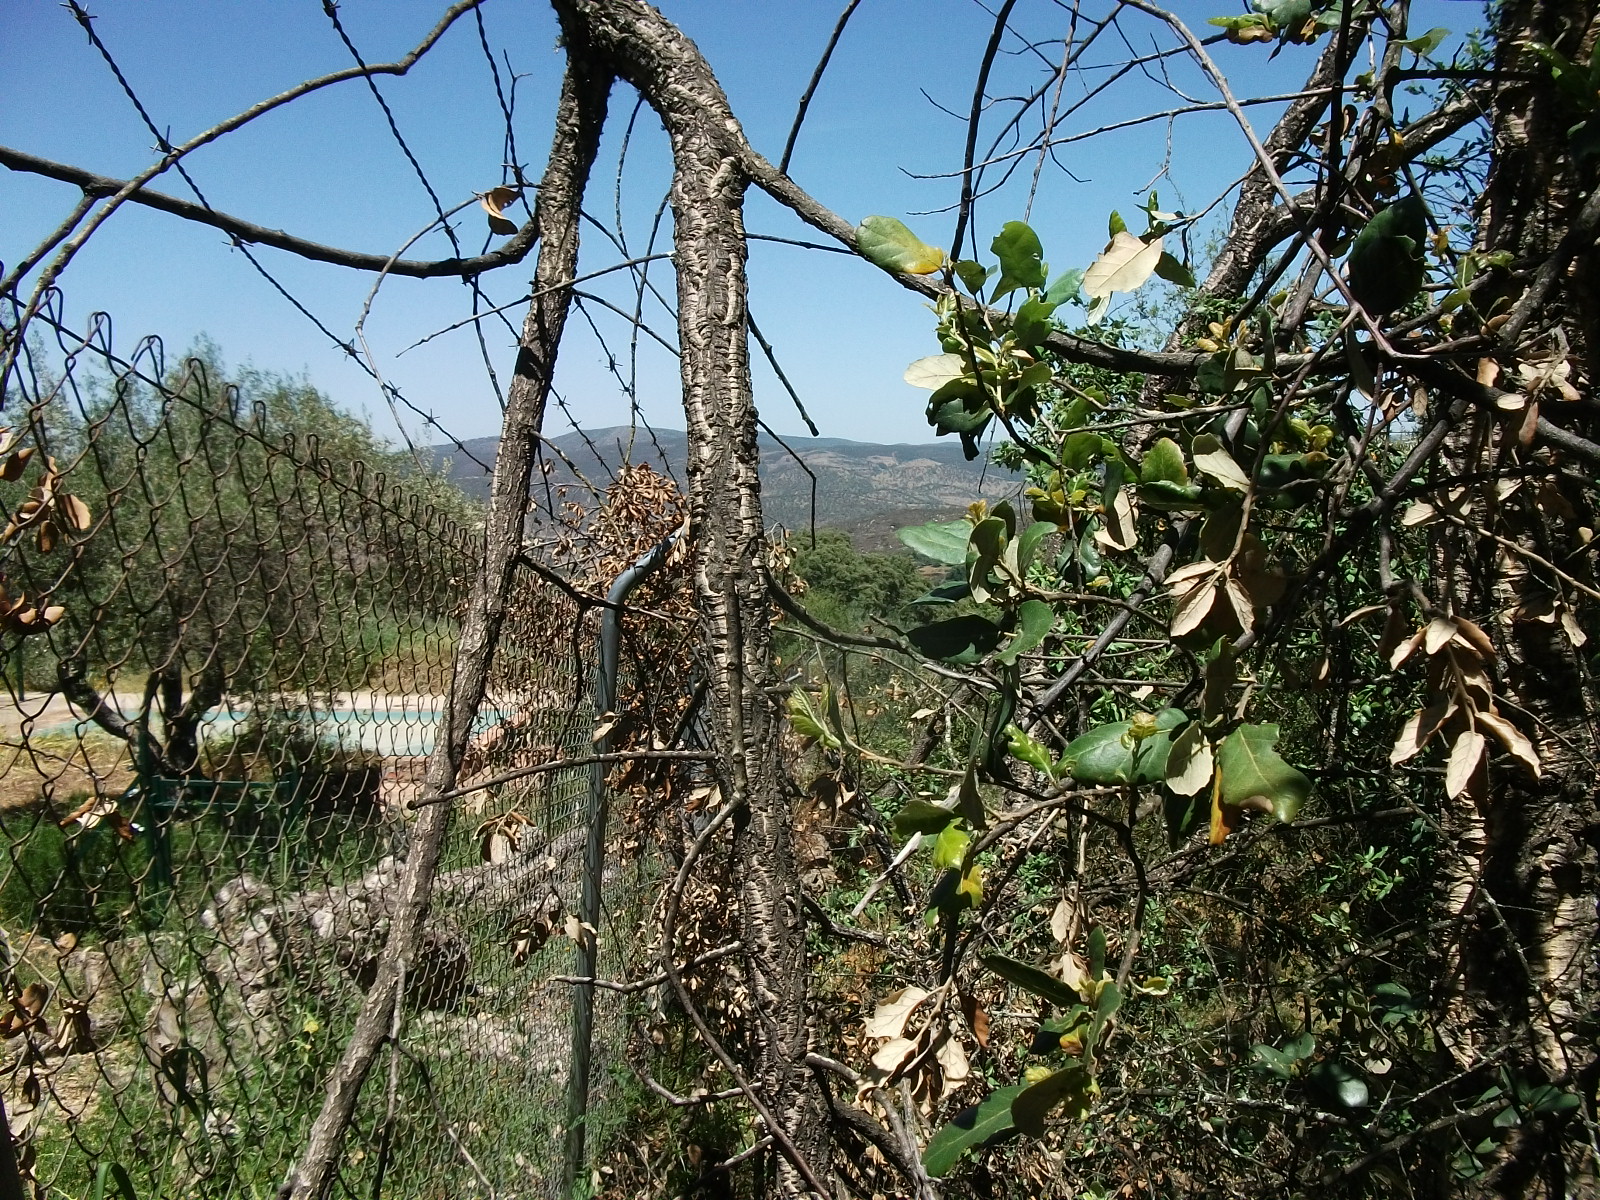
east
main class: Cropland
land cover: Olive groves
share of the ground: 10 - 25 %
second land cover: Spontaneously vegetated surfaces
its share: > 75 %
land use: Agriculture (excluding fallow land and kitchen gardens)
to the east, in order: Olive groves; Spontaneously vegetated surfaces; Fences; Dry stone walls; Broadleaved woodland; Olive groves; Rivers and streams; Dry stone walls; Fences; Broadleaved woodland; Dry stone walls; Broadleaved woodland; Dry stone walls; Tracks; Dry stone walls; Fences; Broadleaved woodland; Pine dominated coniferous woodland
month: May
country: ES
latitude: 37.9346
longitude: -6.6228
